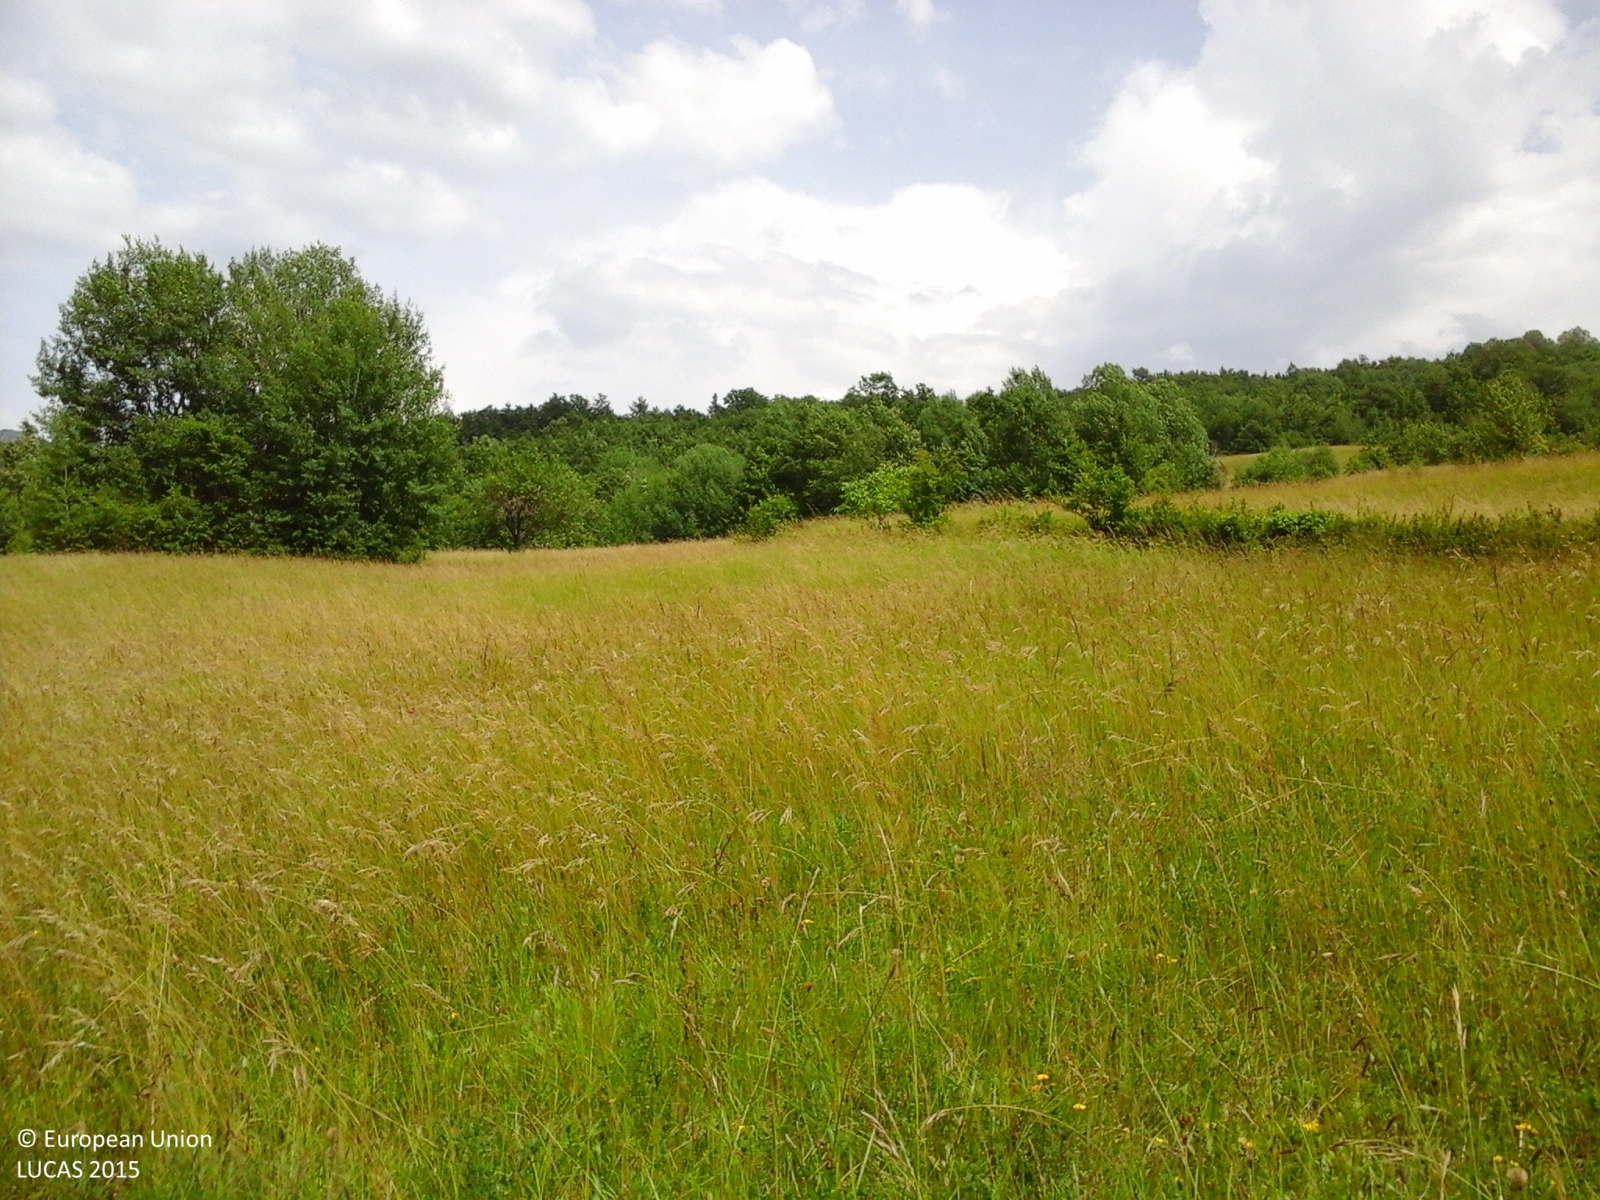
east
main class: Grassland
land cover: Grassland without tree/shrub cover
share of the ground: > 75 %
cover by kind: herbaceous plants 100 %
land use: Agriculture (excluding fallow land and kitchen gardens)
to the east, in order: Grassland without tree/shrub cover; Abandoned hedges; Grassland without tree/shrub cover; Broadleaved woodland; Grassland without tree/shrub cover; Paved roads, cycling and walking lanes; Ditches and canals; Managed hedges; Grassland without tree/shrub cover; Broadleaved woodland
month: June
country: IT
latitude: 44.6744
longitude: 9.6098
